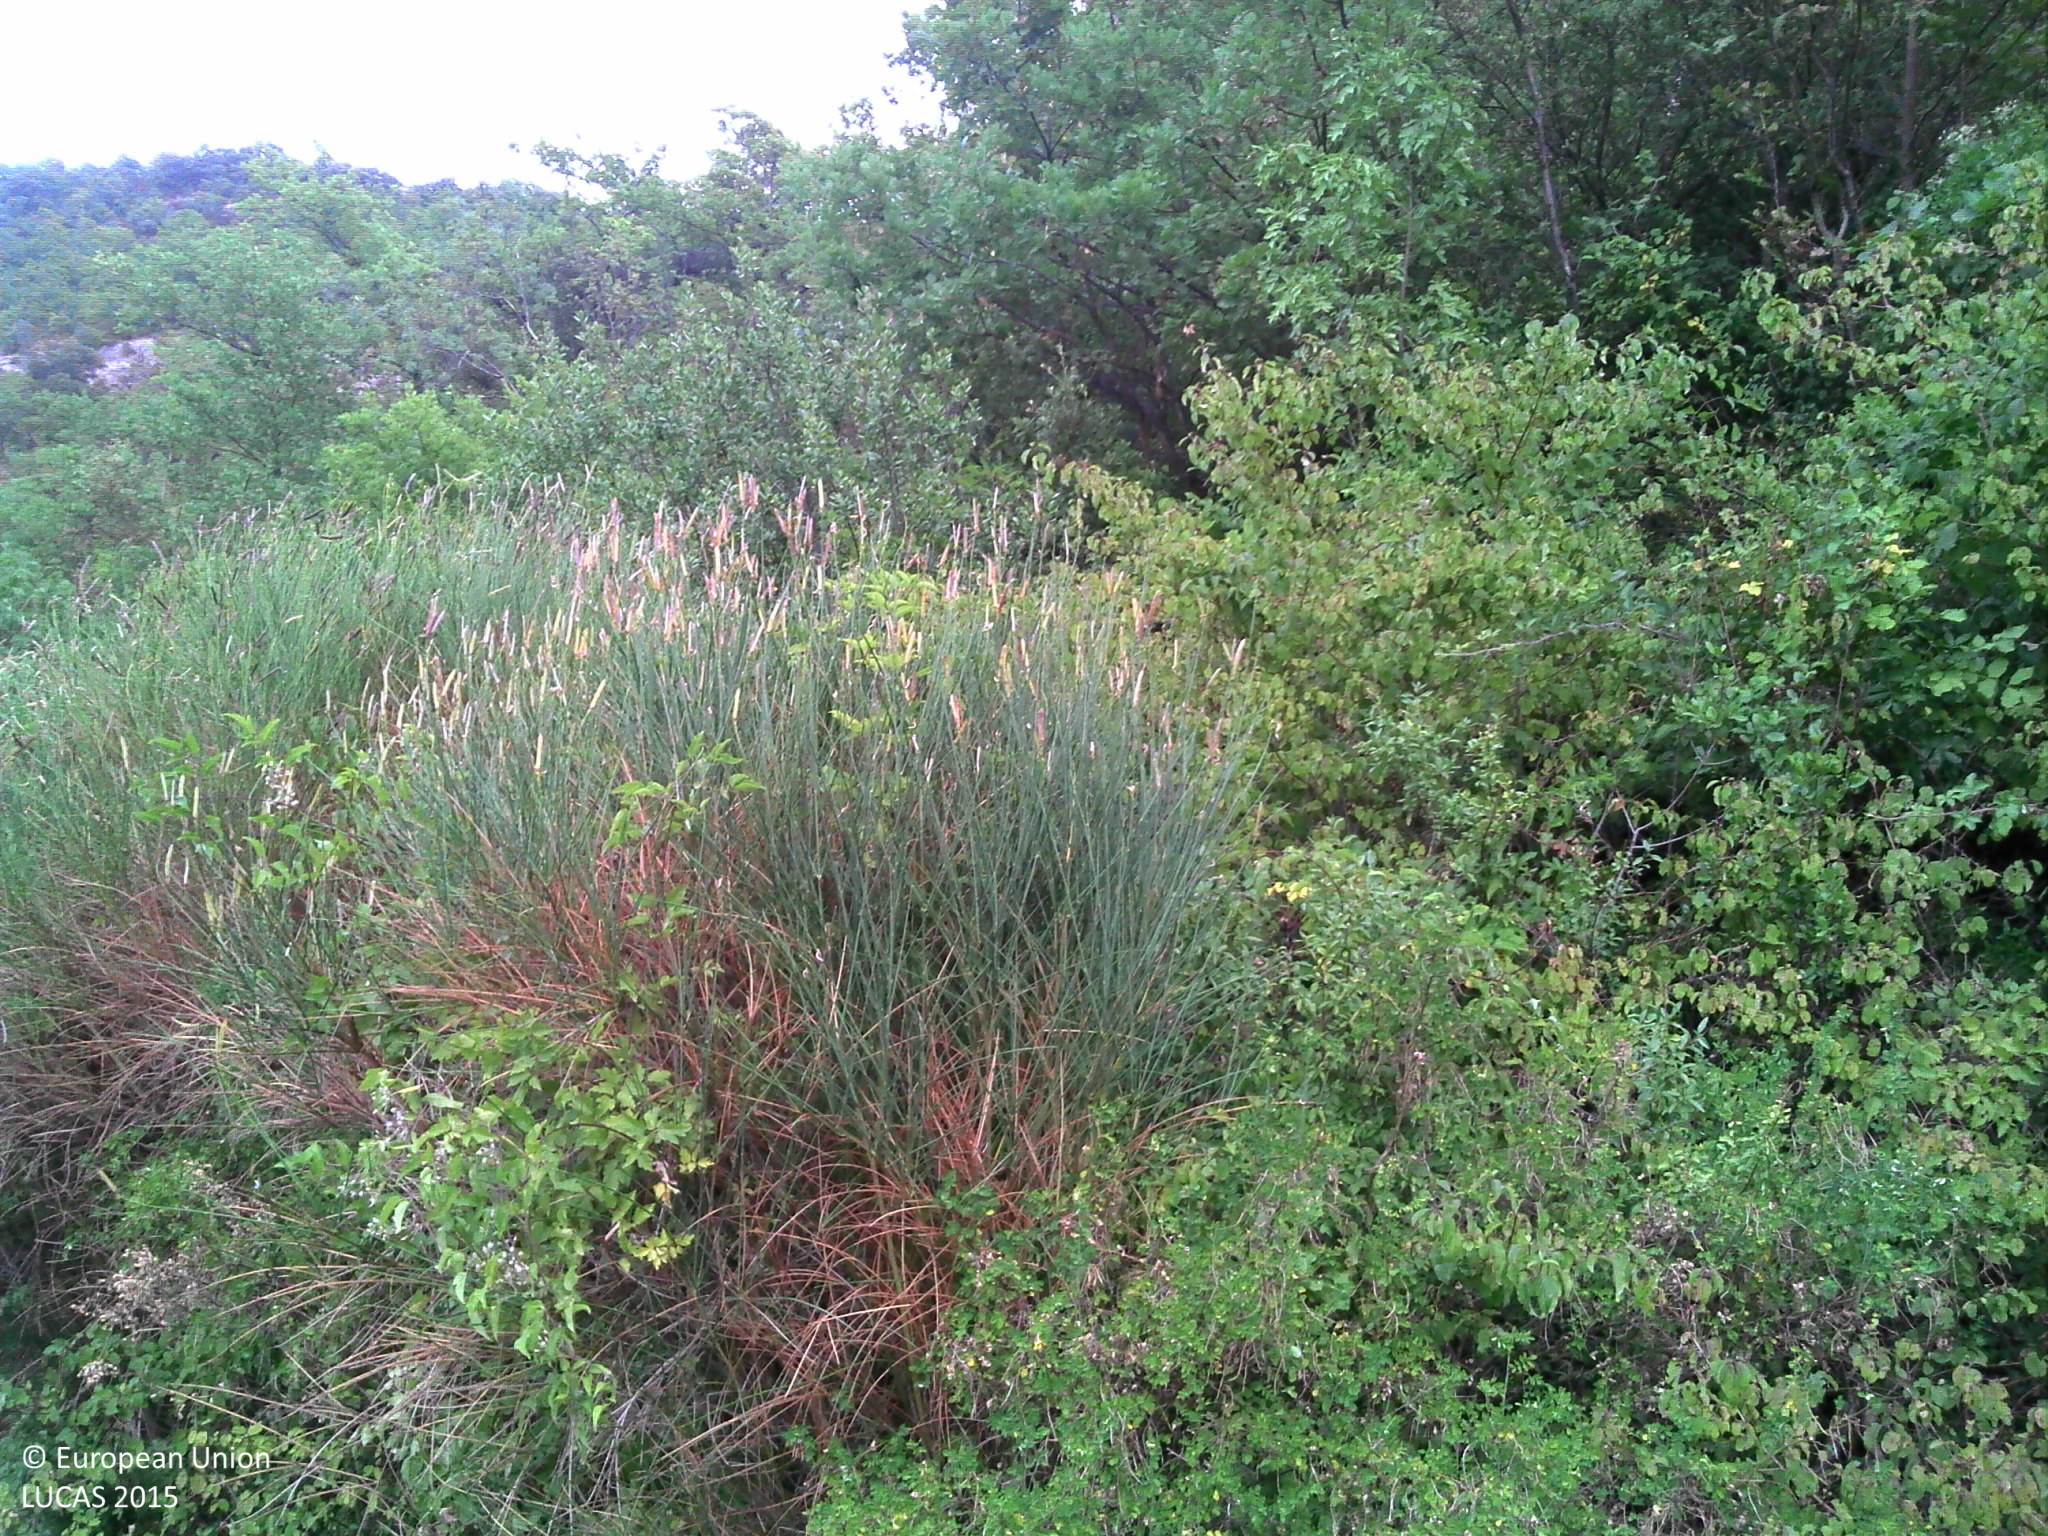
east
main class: Woodland
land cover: Broadleaved woodland
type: broadleaved evergreen forest
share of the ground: > 75 %
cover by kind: broadleaved forest trees 90 %, herbaceous plants 10 %
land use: Semi-natural and natural areas not in use
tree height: > 5 m
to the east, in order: Broadleaved woodland
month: July
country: FR
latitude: 44.4817
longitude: 4.6130
